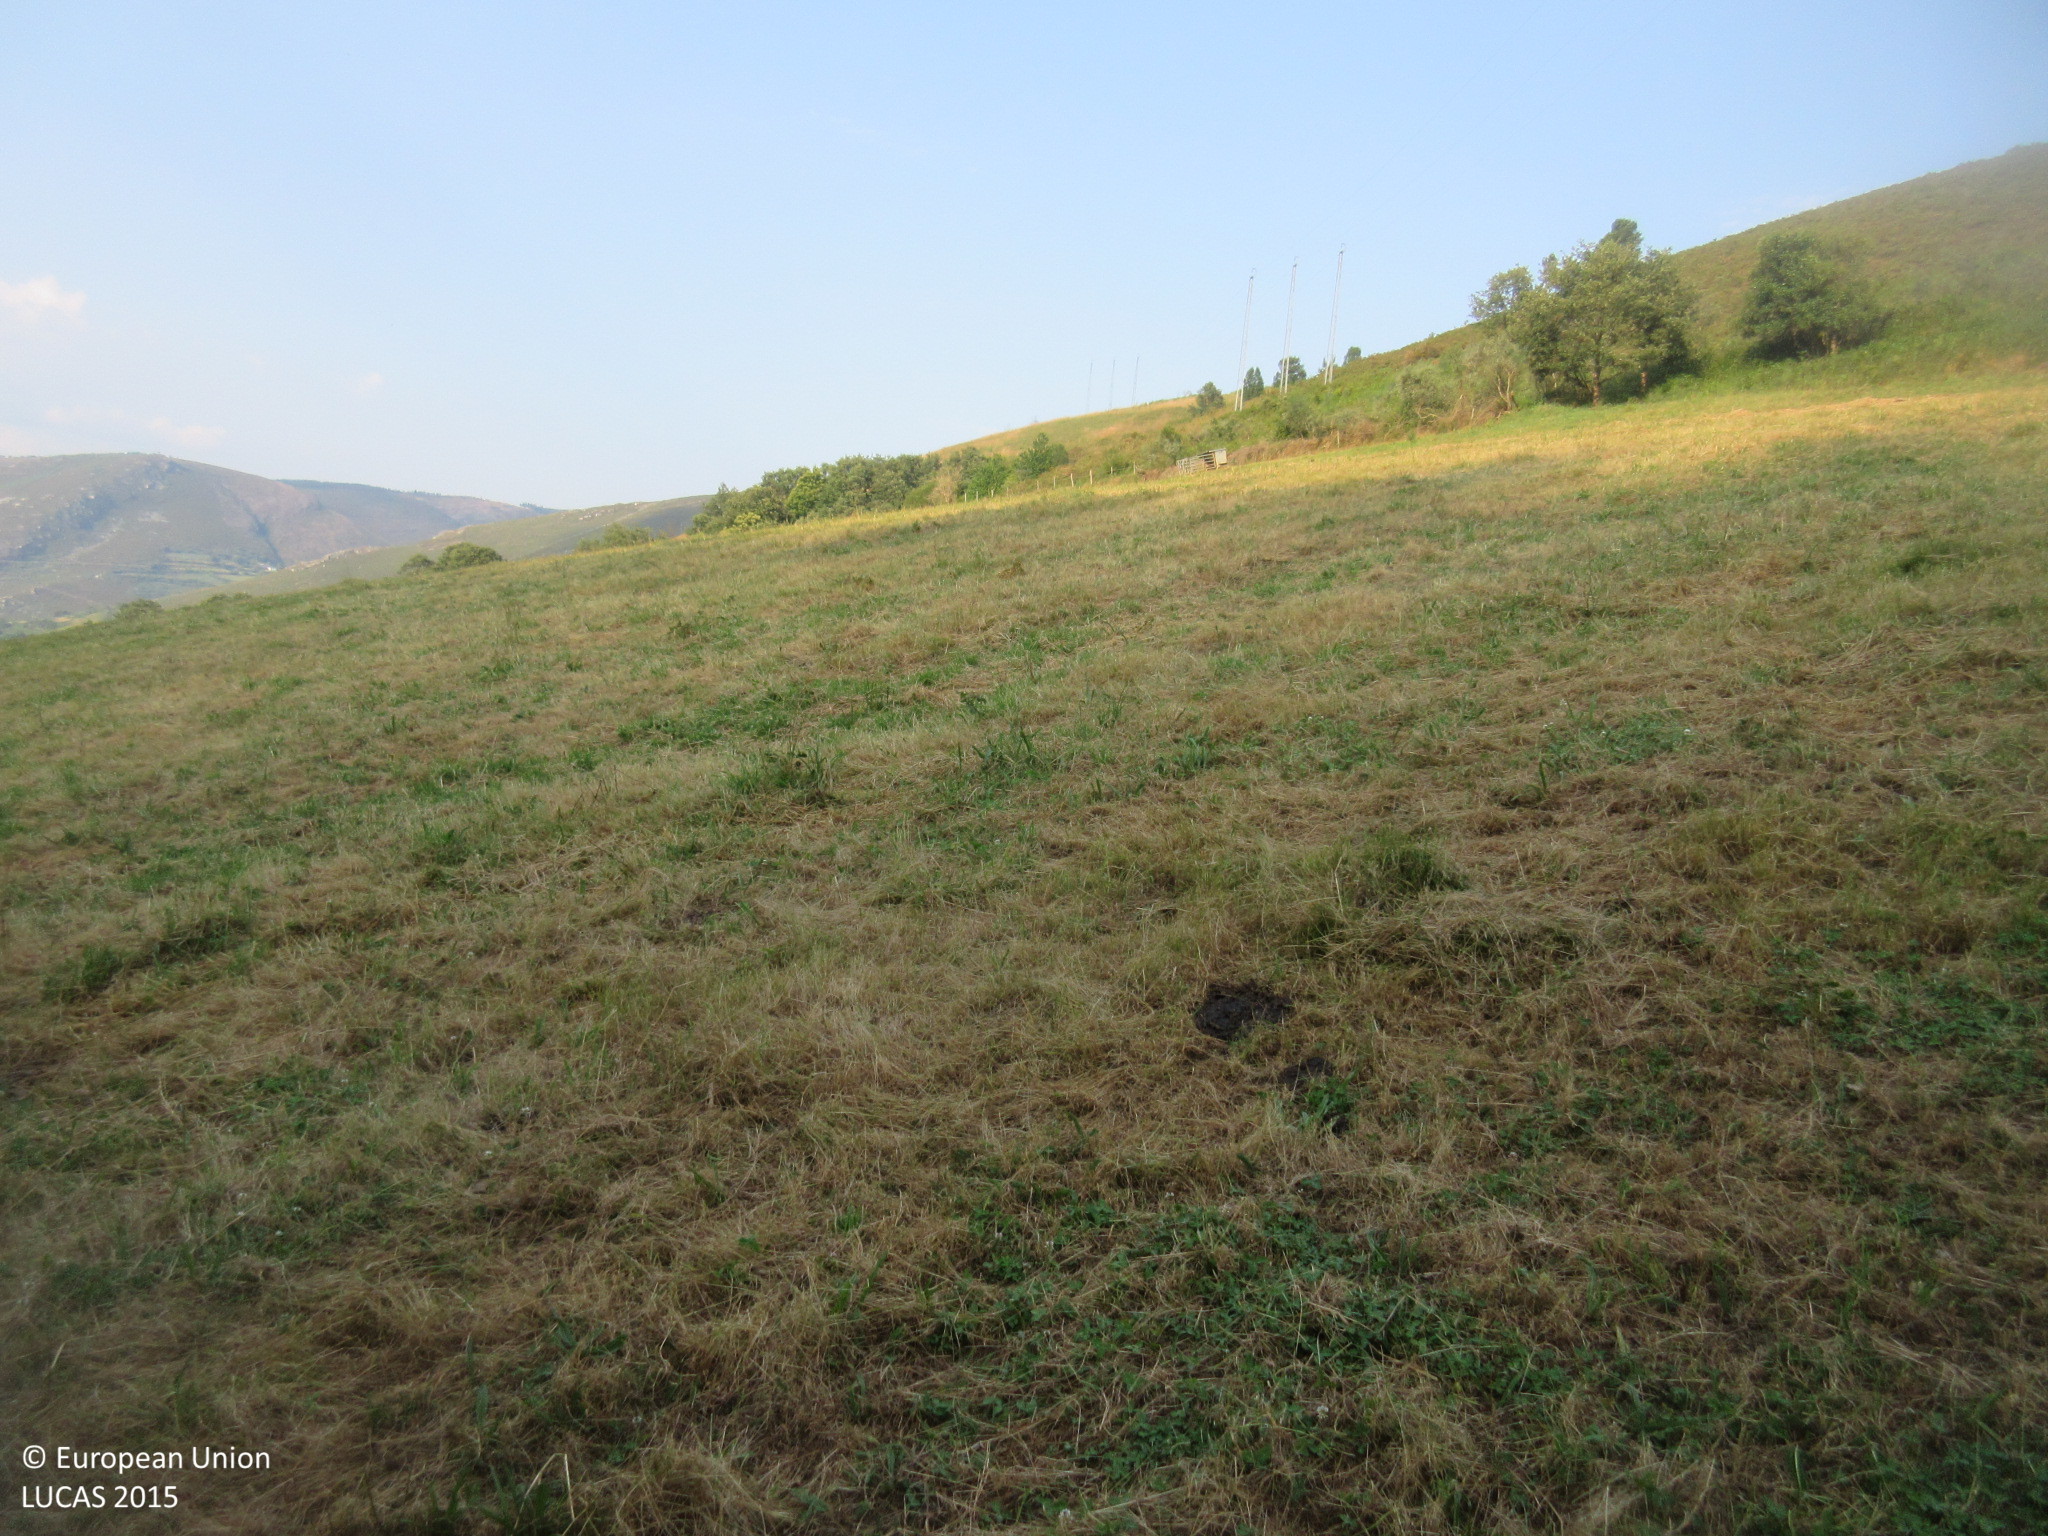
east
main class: Grassland
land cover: Grassland without tree/shrub cover
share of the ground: > 75 %
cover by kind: herbaceous plants 100 %
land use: Agriculture (excluding fallow land and kitchen gardens)
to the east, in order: Grassland without tree/shrub cover; Shrubland with sparse tree cover; Grass margins; Paved roads, cycling and walking lanes; Grass margins; Shrubland with sparse tree cover; Tracks; Shrubland without tree cover
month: June
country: ES
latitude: 42.9379
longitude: -6.9843
